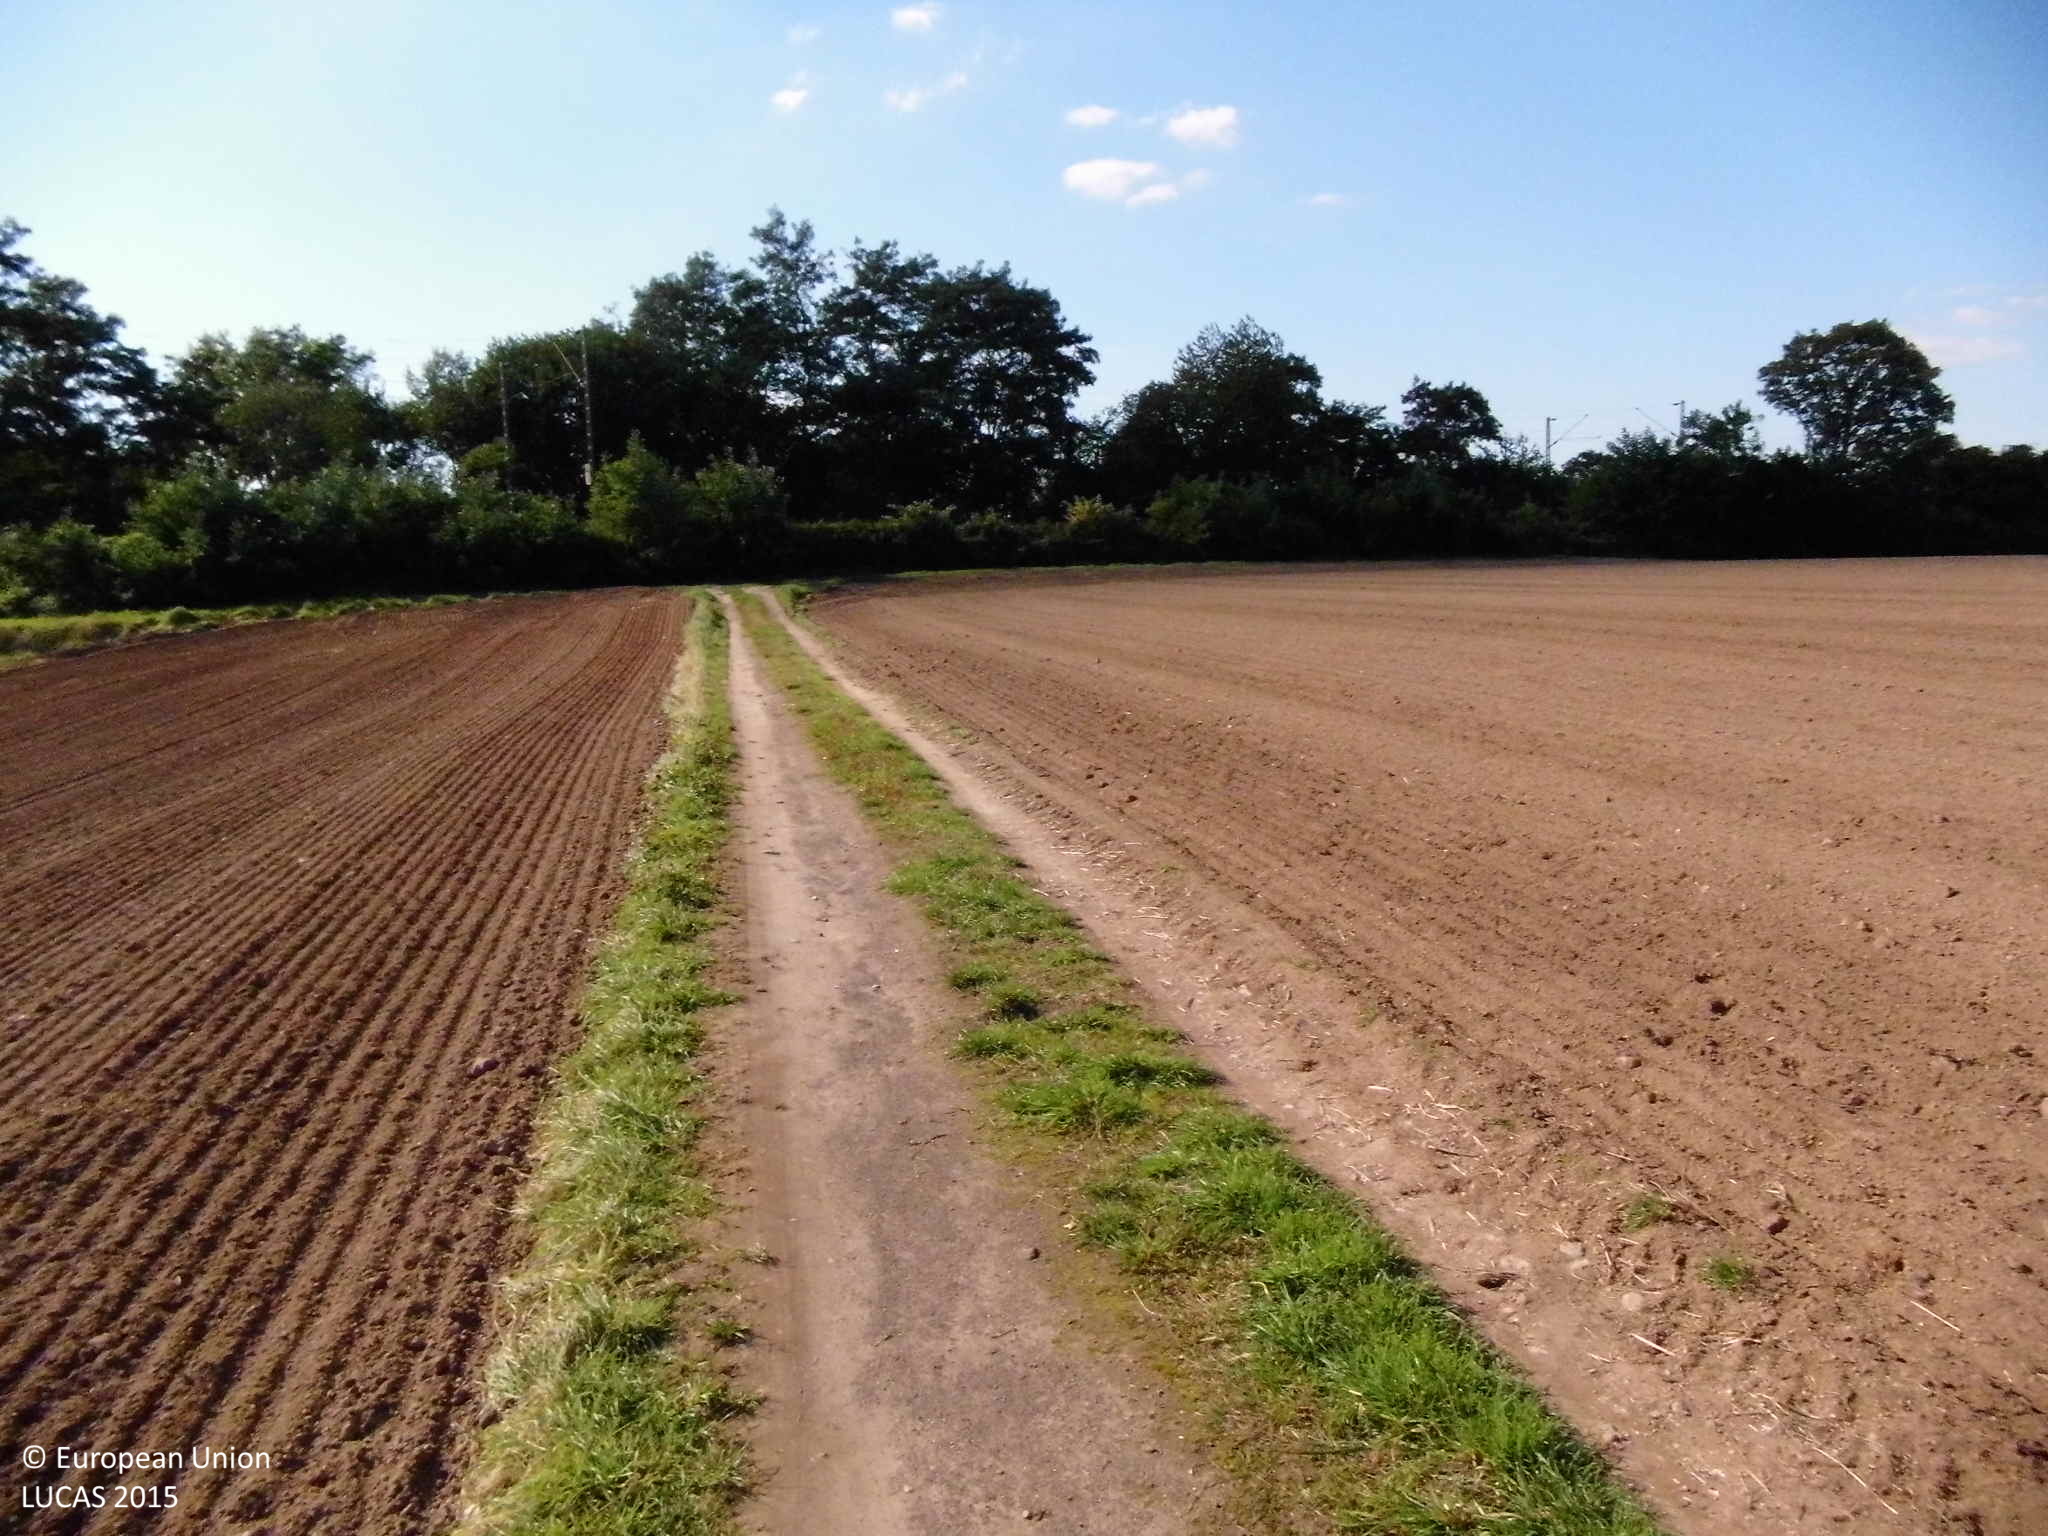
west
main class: Cropland
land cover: Common wheat
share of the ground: < 10 %
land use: Agriculture (excluding fallow land and kitchen gardens)
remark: Tilled/Sowed
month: September
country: DE
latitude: 50.4095
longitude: 7.5378
